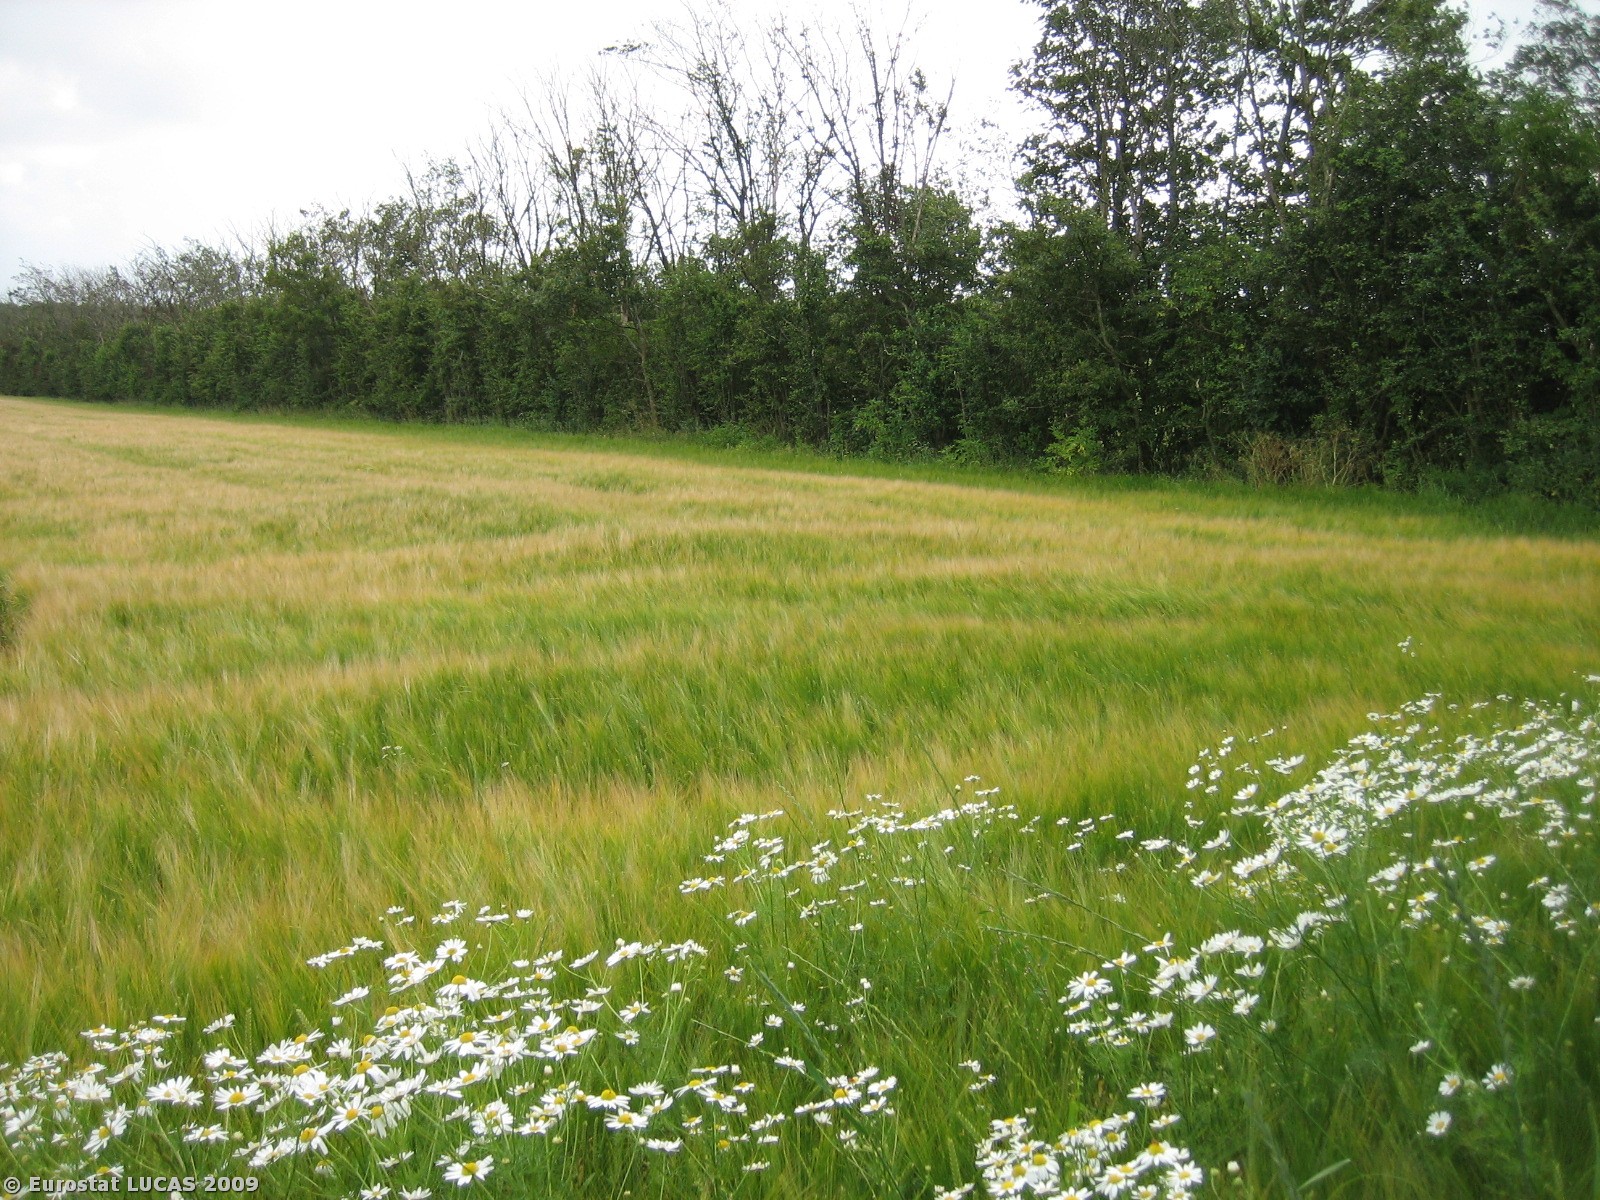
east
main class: Cropland
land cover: Barley
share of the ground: > 75 %
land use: Agriculture (excluding fallow land and kitchen gardens)
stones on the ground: 10 - 25 %
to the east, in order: Barley; Broadleaved woodland
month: July
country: DK
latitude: 55.5332
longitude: 8.6228
